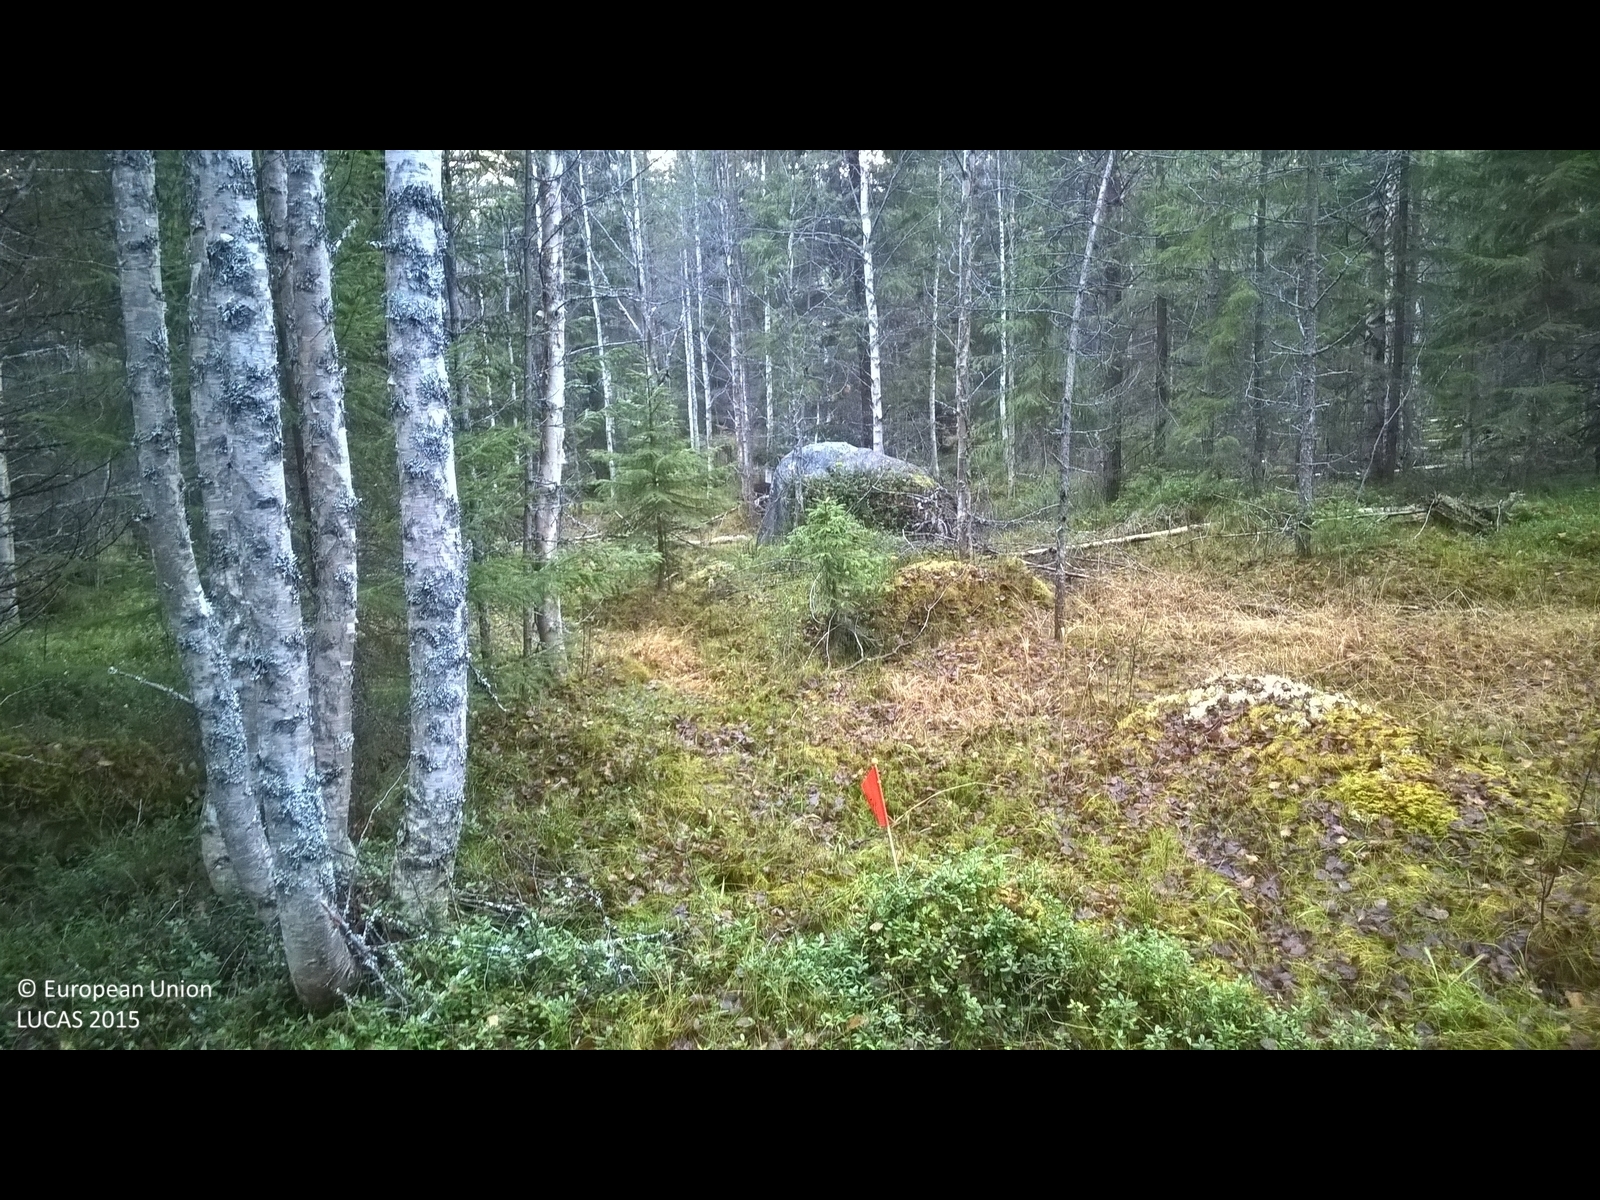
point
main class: Woodland
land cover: Spruce dominated mixed woodland
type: boreal forest
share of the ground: > 75 %
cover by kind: coniferous forest trees 40 %, broadleaved forest trees 40 %, lichens and mosses 20 %
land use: Forestry
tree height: > 5 m
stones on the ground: < 10 %
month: November
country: SE
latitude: 62.7599
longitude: 15.6379
